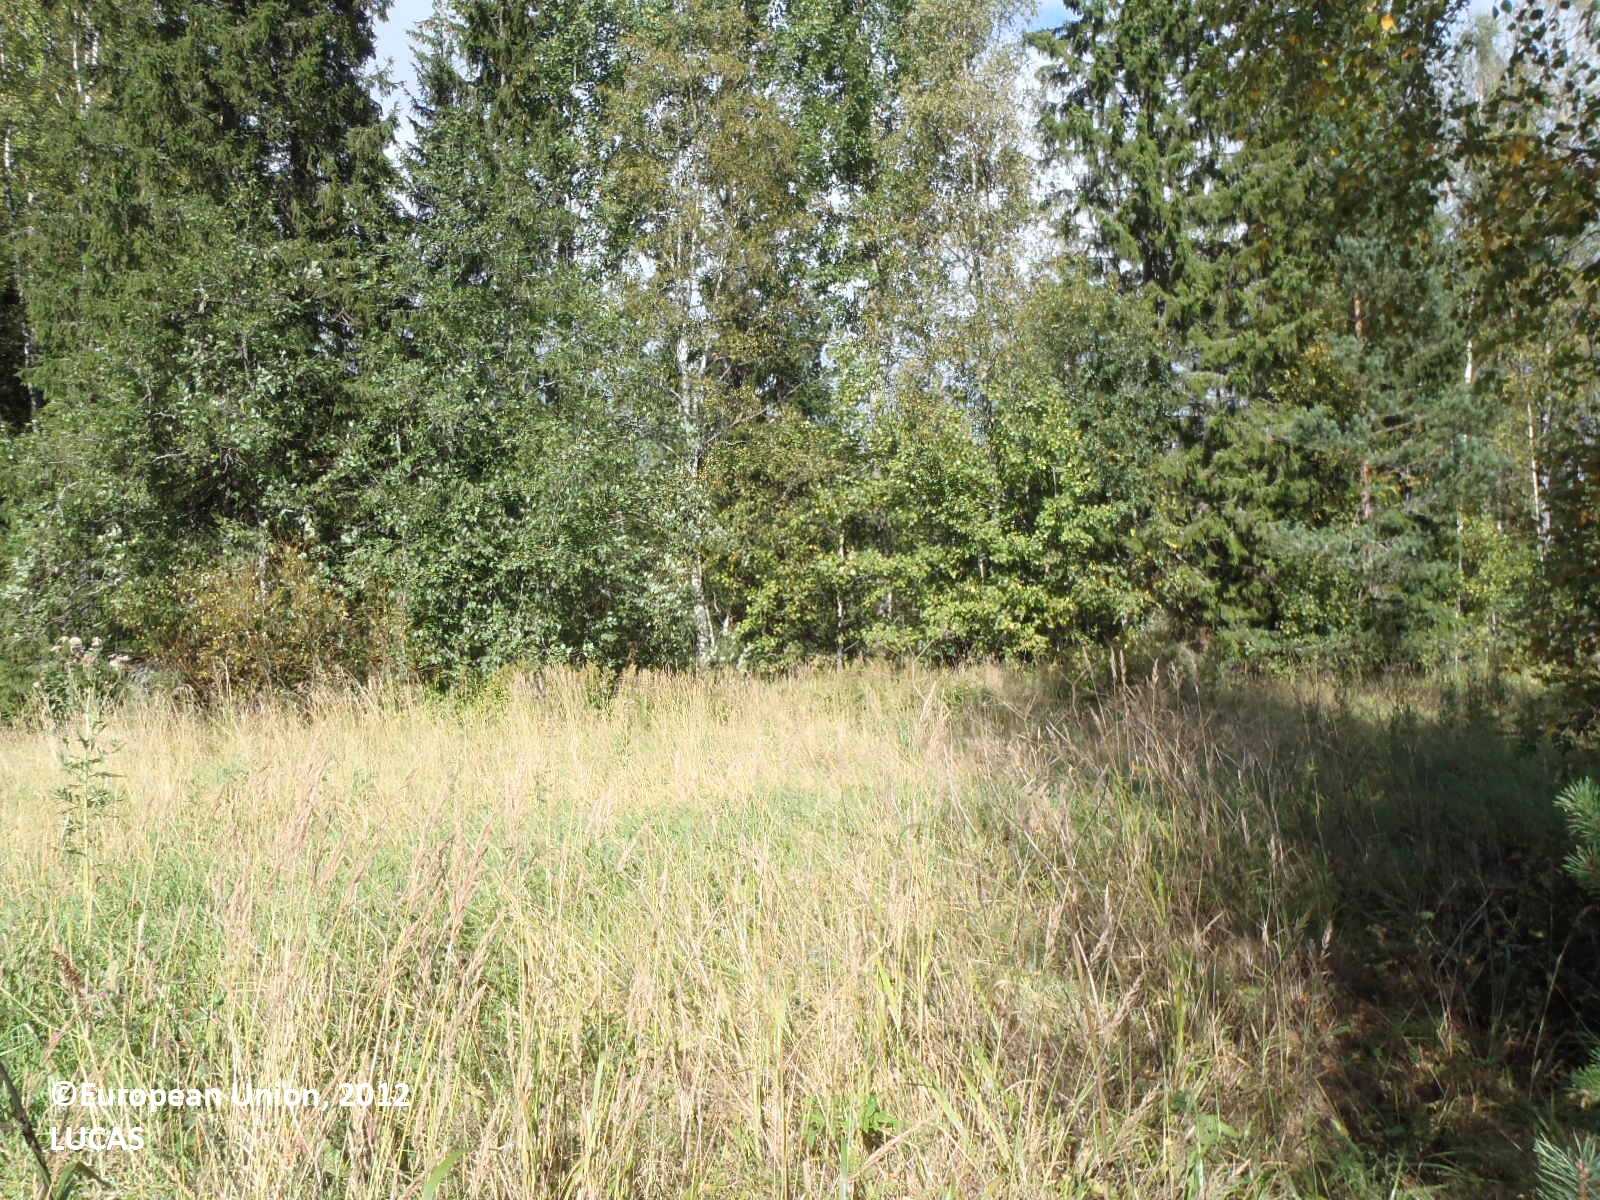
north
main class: Grassland
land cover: Grassland without tree/shrub cover
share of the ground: > 75 %
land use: Residential
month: September
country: FI
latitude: 61.3591
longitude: 22.6913
